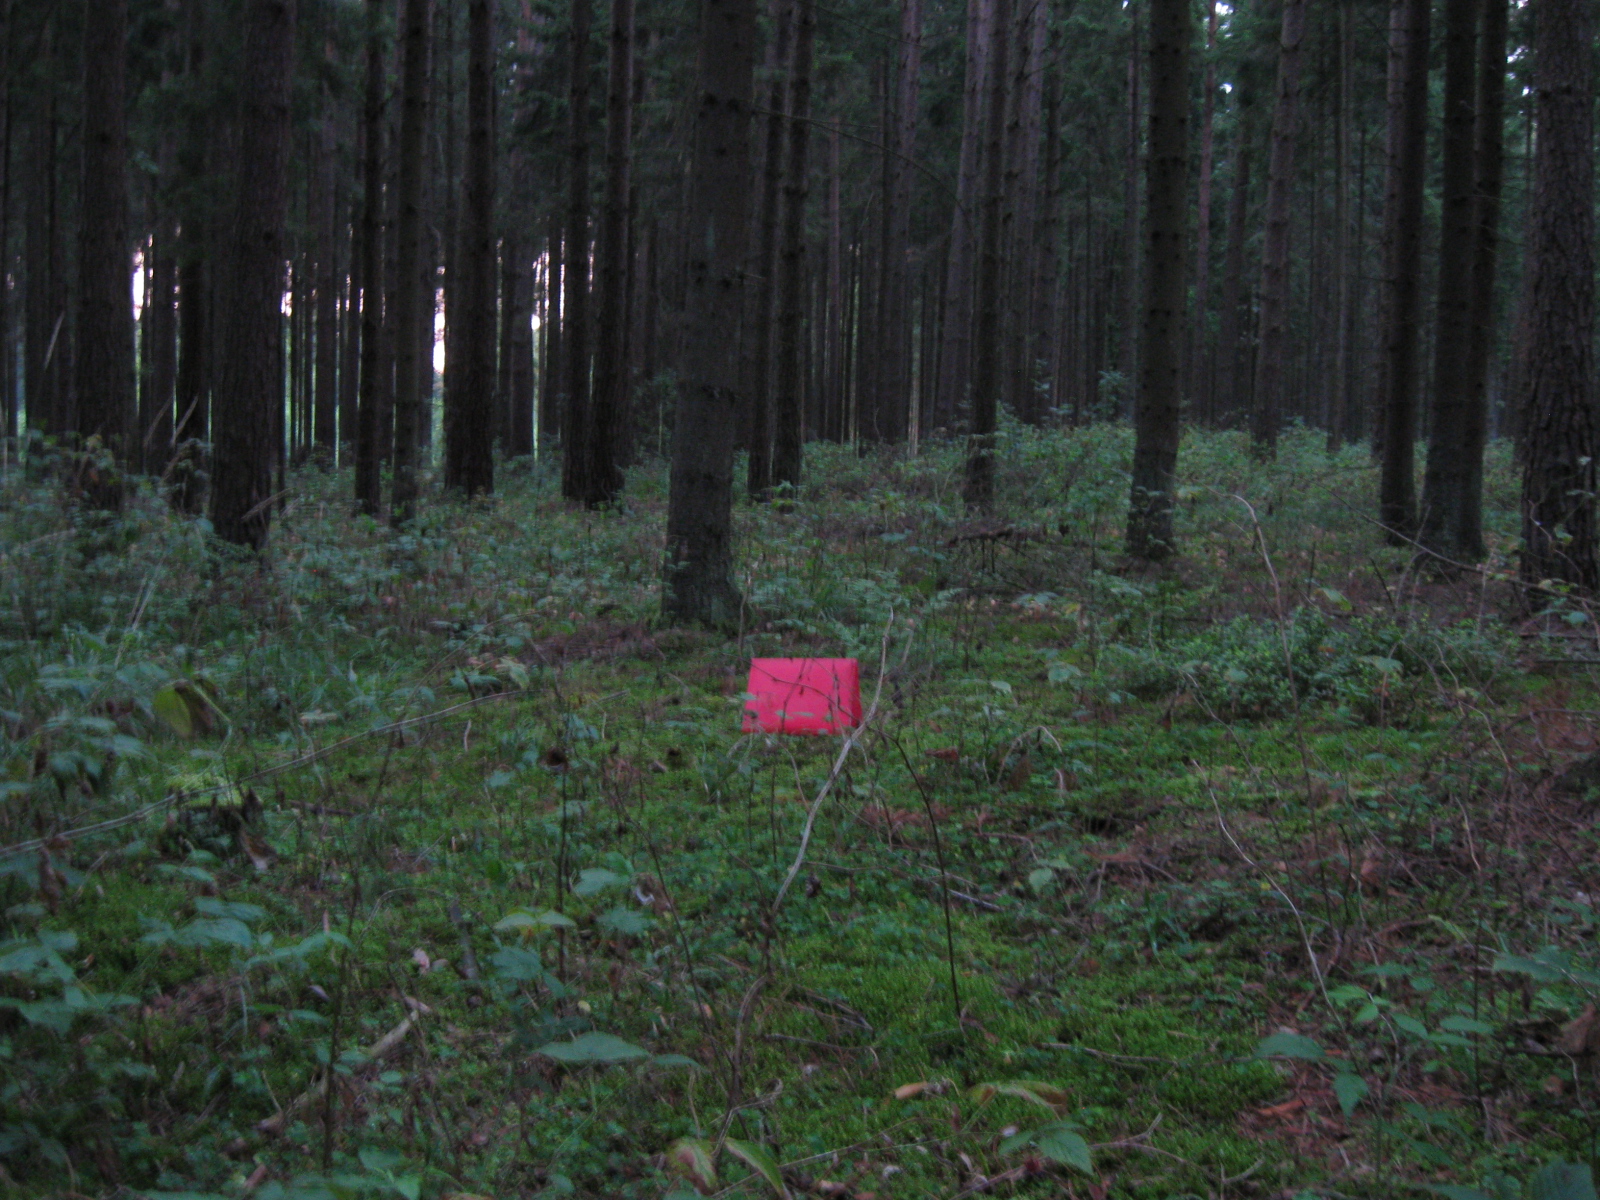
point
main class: Woodland
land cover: Pine dominated coniferous woodland
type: hemiboreal forest and nemoral coniferous forest and mixed broadleaved-coniferous forest
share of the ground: > 75 %
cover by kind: coniferous forest trees 75 %, herbaceous plants 10 %, lichens and mosses 10 %, shrubs 5 %
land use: Forestry
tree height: > 5 m
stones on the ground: < 10 %
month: August
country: LT
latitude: 54.6960
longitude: 23.5659
